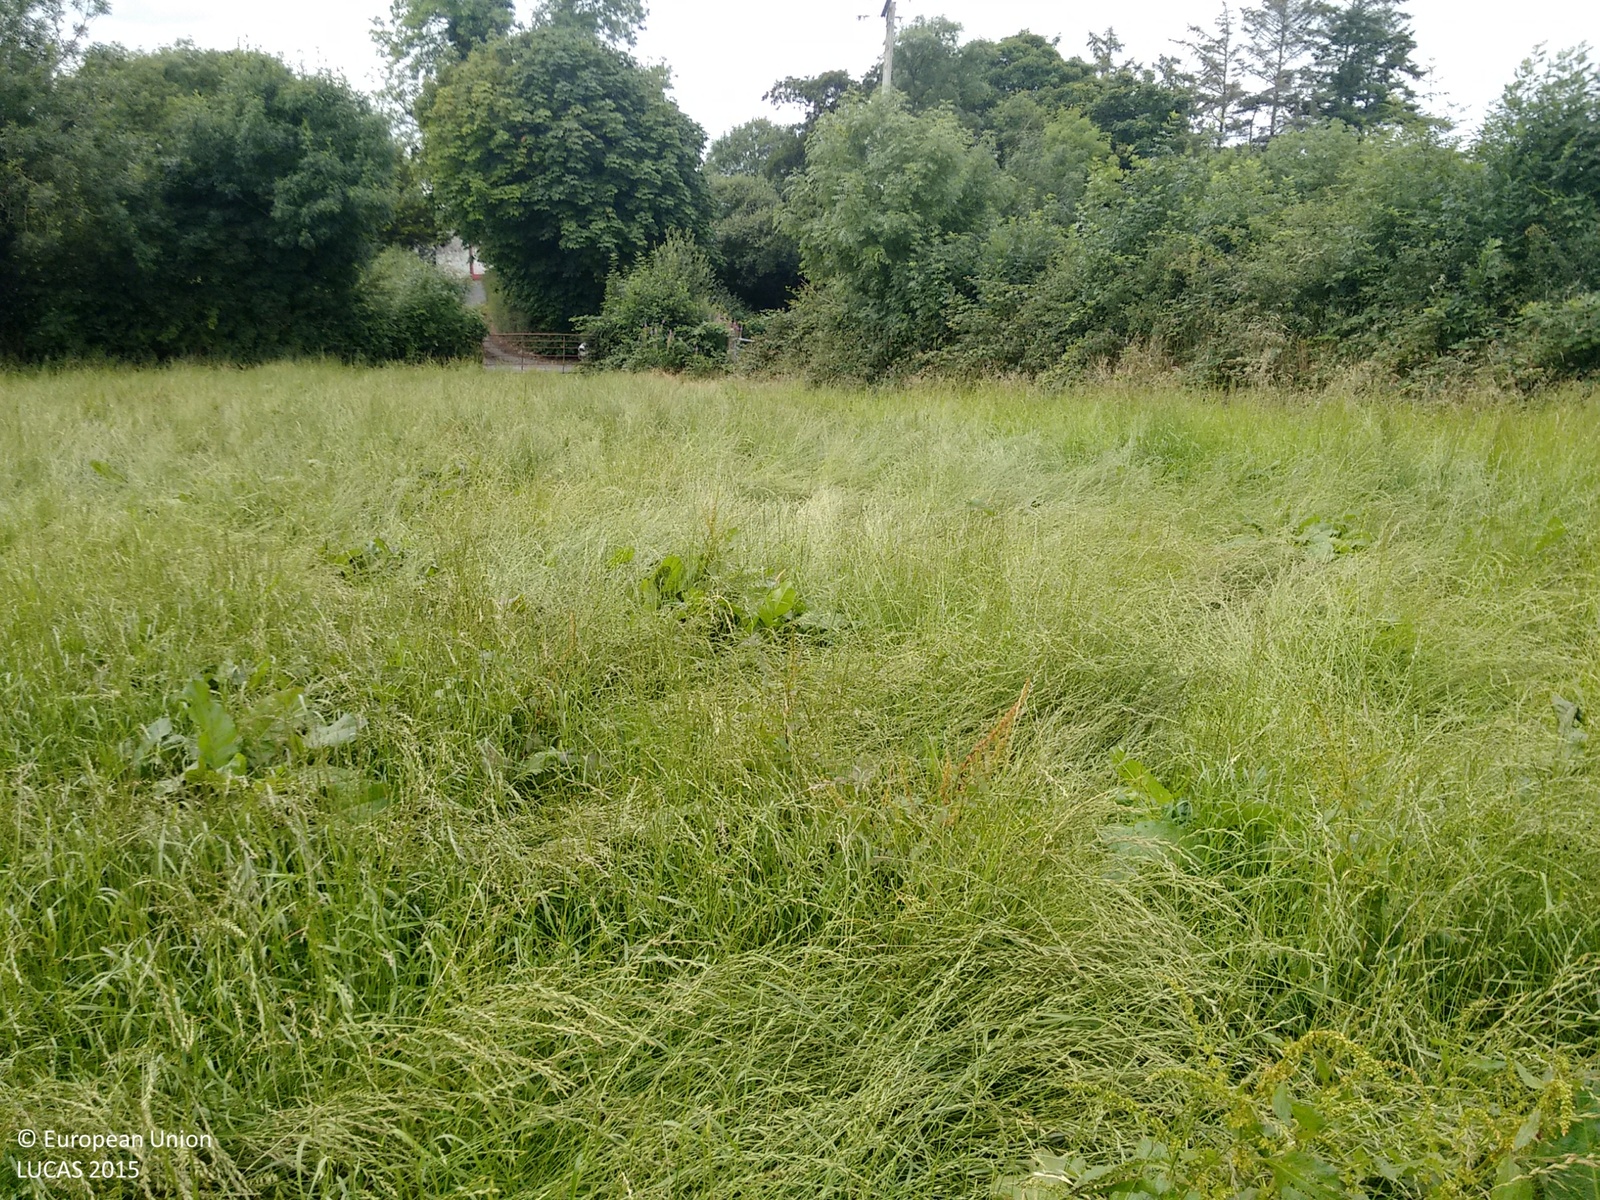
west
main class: Grassland
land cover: Grassland without tree/shrub cover
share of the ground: > 75 %
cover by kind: herbaceous plants 100 %
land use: Agriculture (excluding fallow land and kitchen gardens)
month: August
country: GB
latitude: 54.0585
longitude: -6.6443
